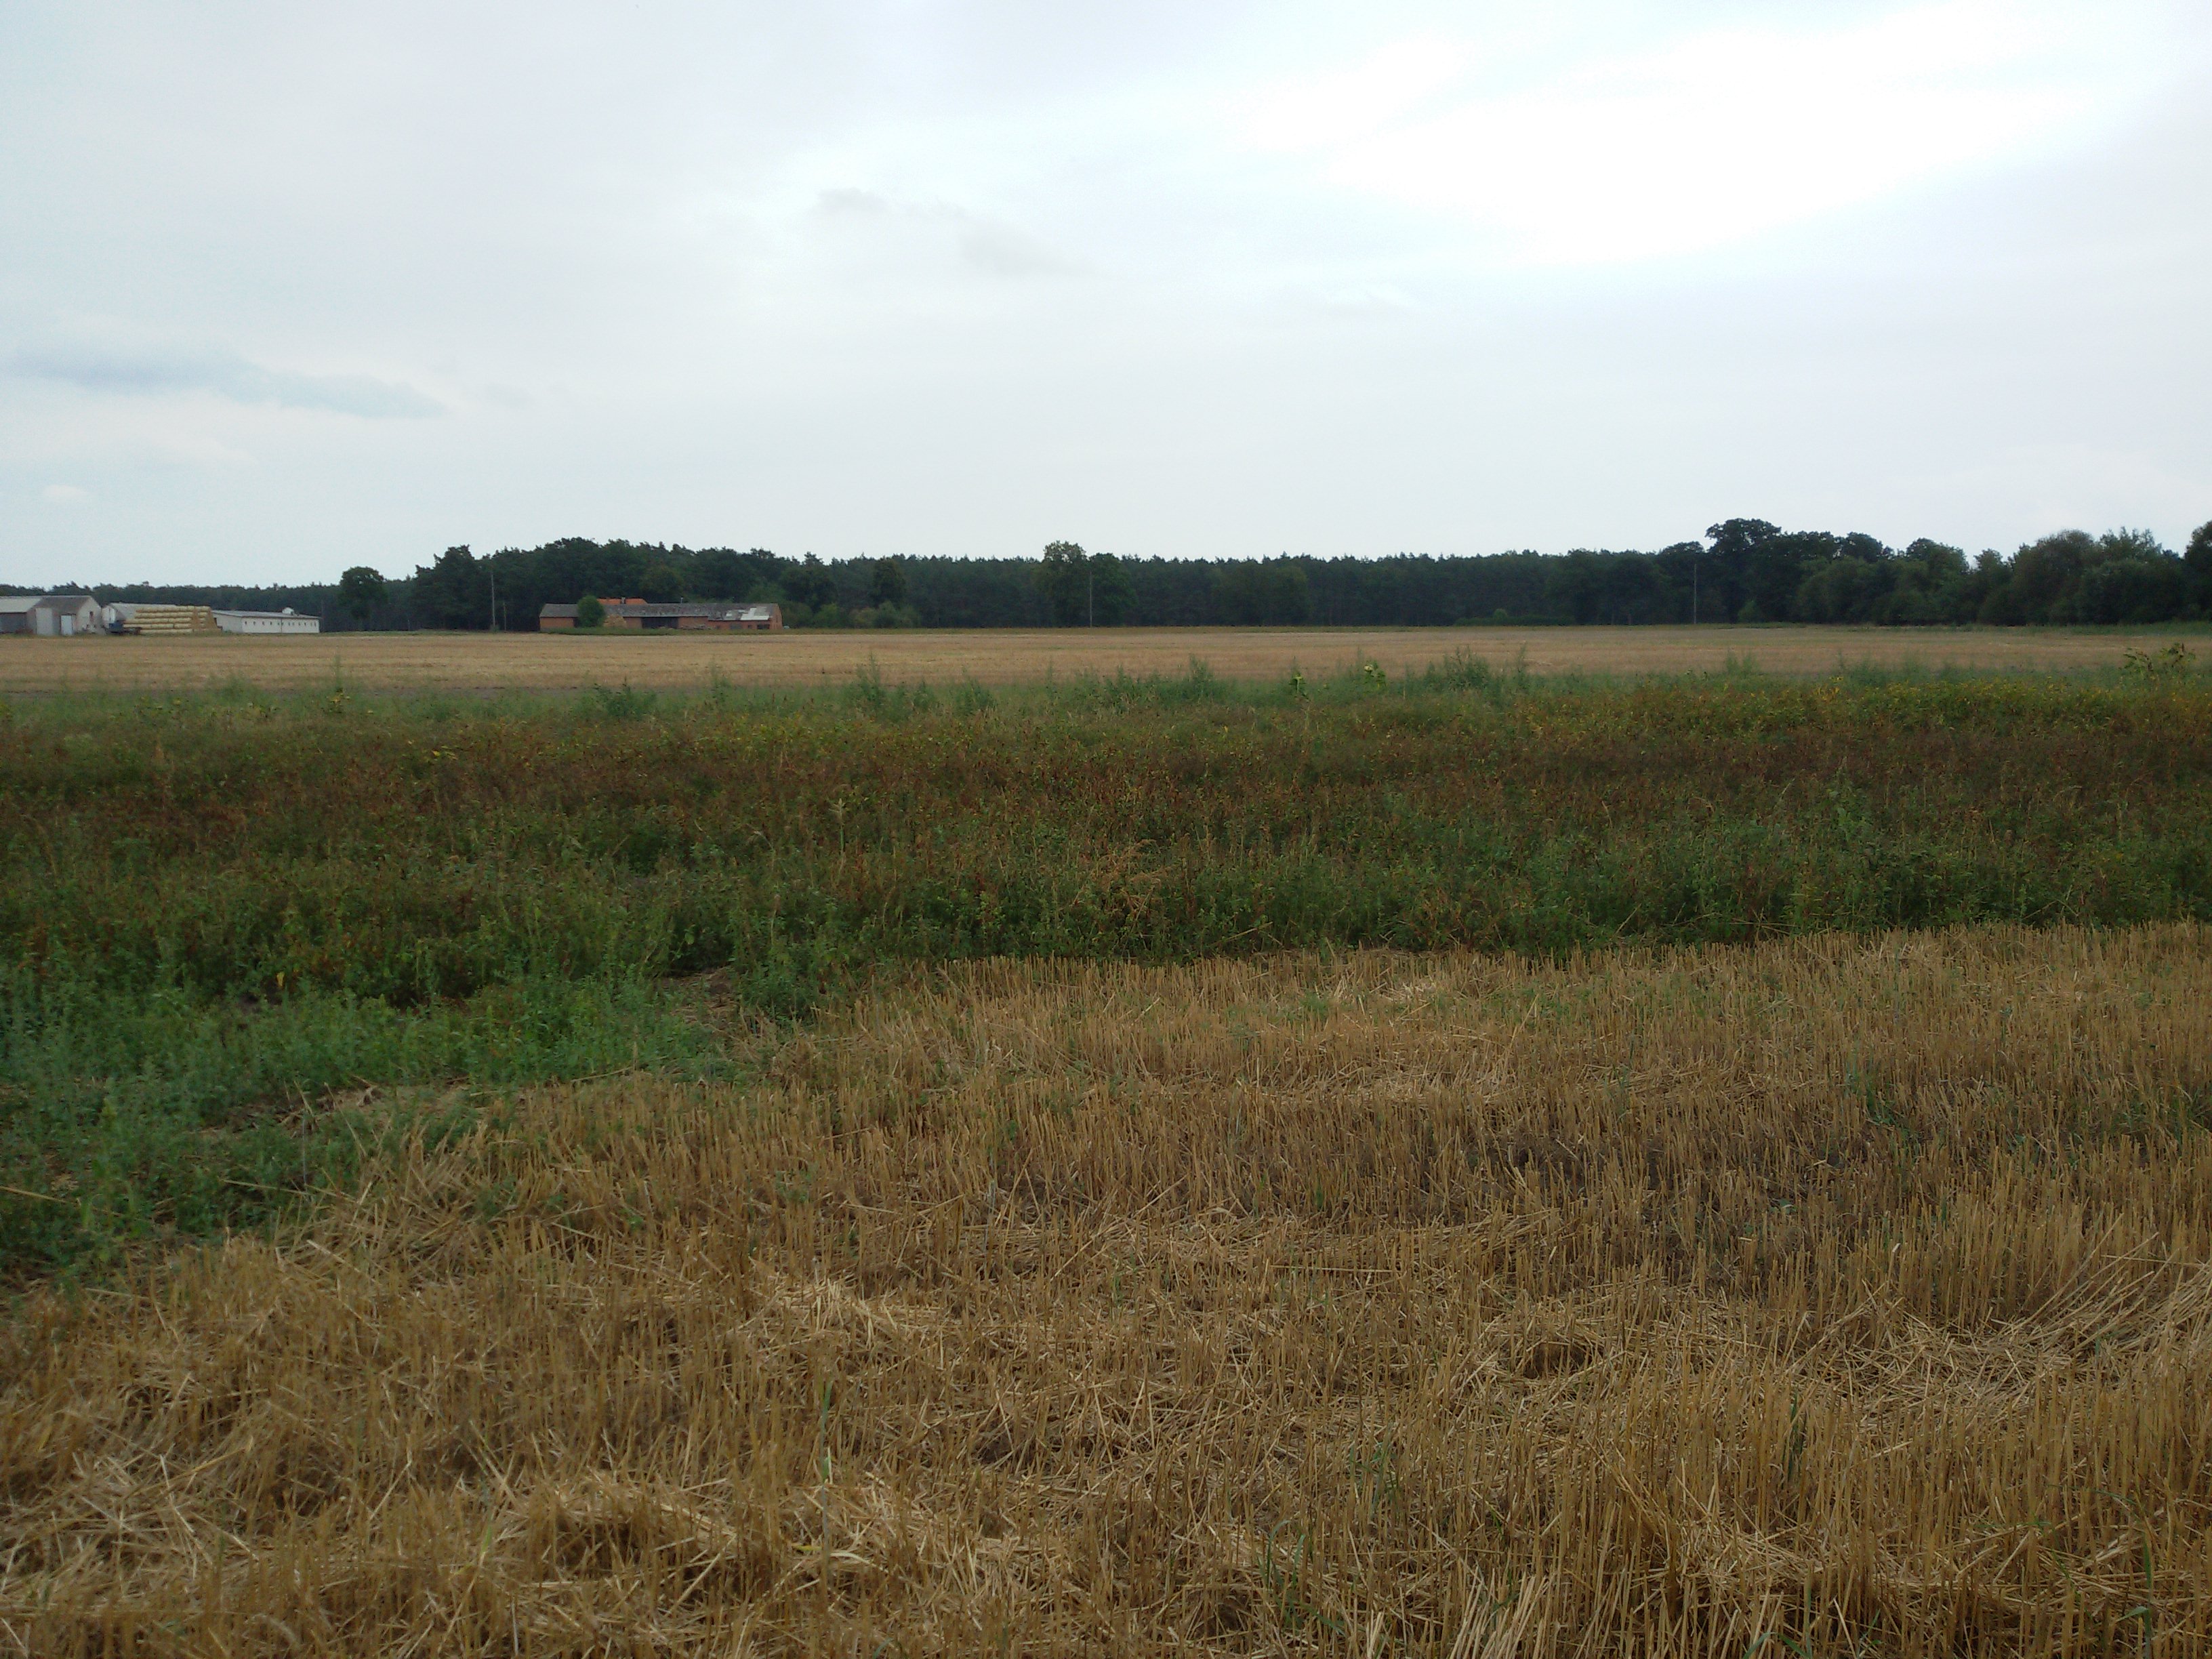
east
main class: Cropland
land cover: Common wheat
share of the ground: > 75 %
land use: Agriculture (excluding fallow land and kitchen gardens)
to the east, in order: Common wheat; Potatoes; Rye
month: August
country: PL
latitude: 51.7183
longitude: 17.8749
